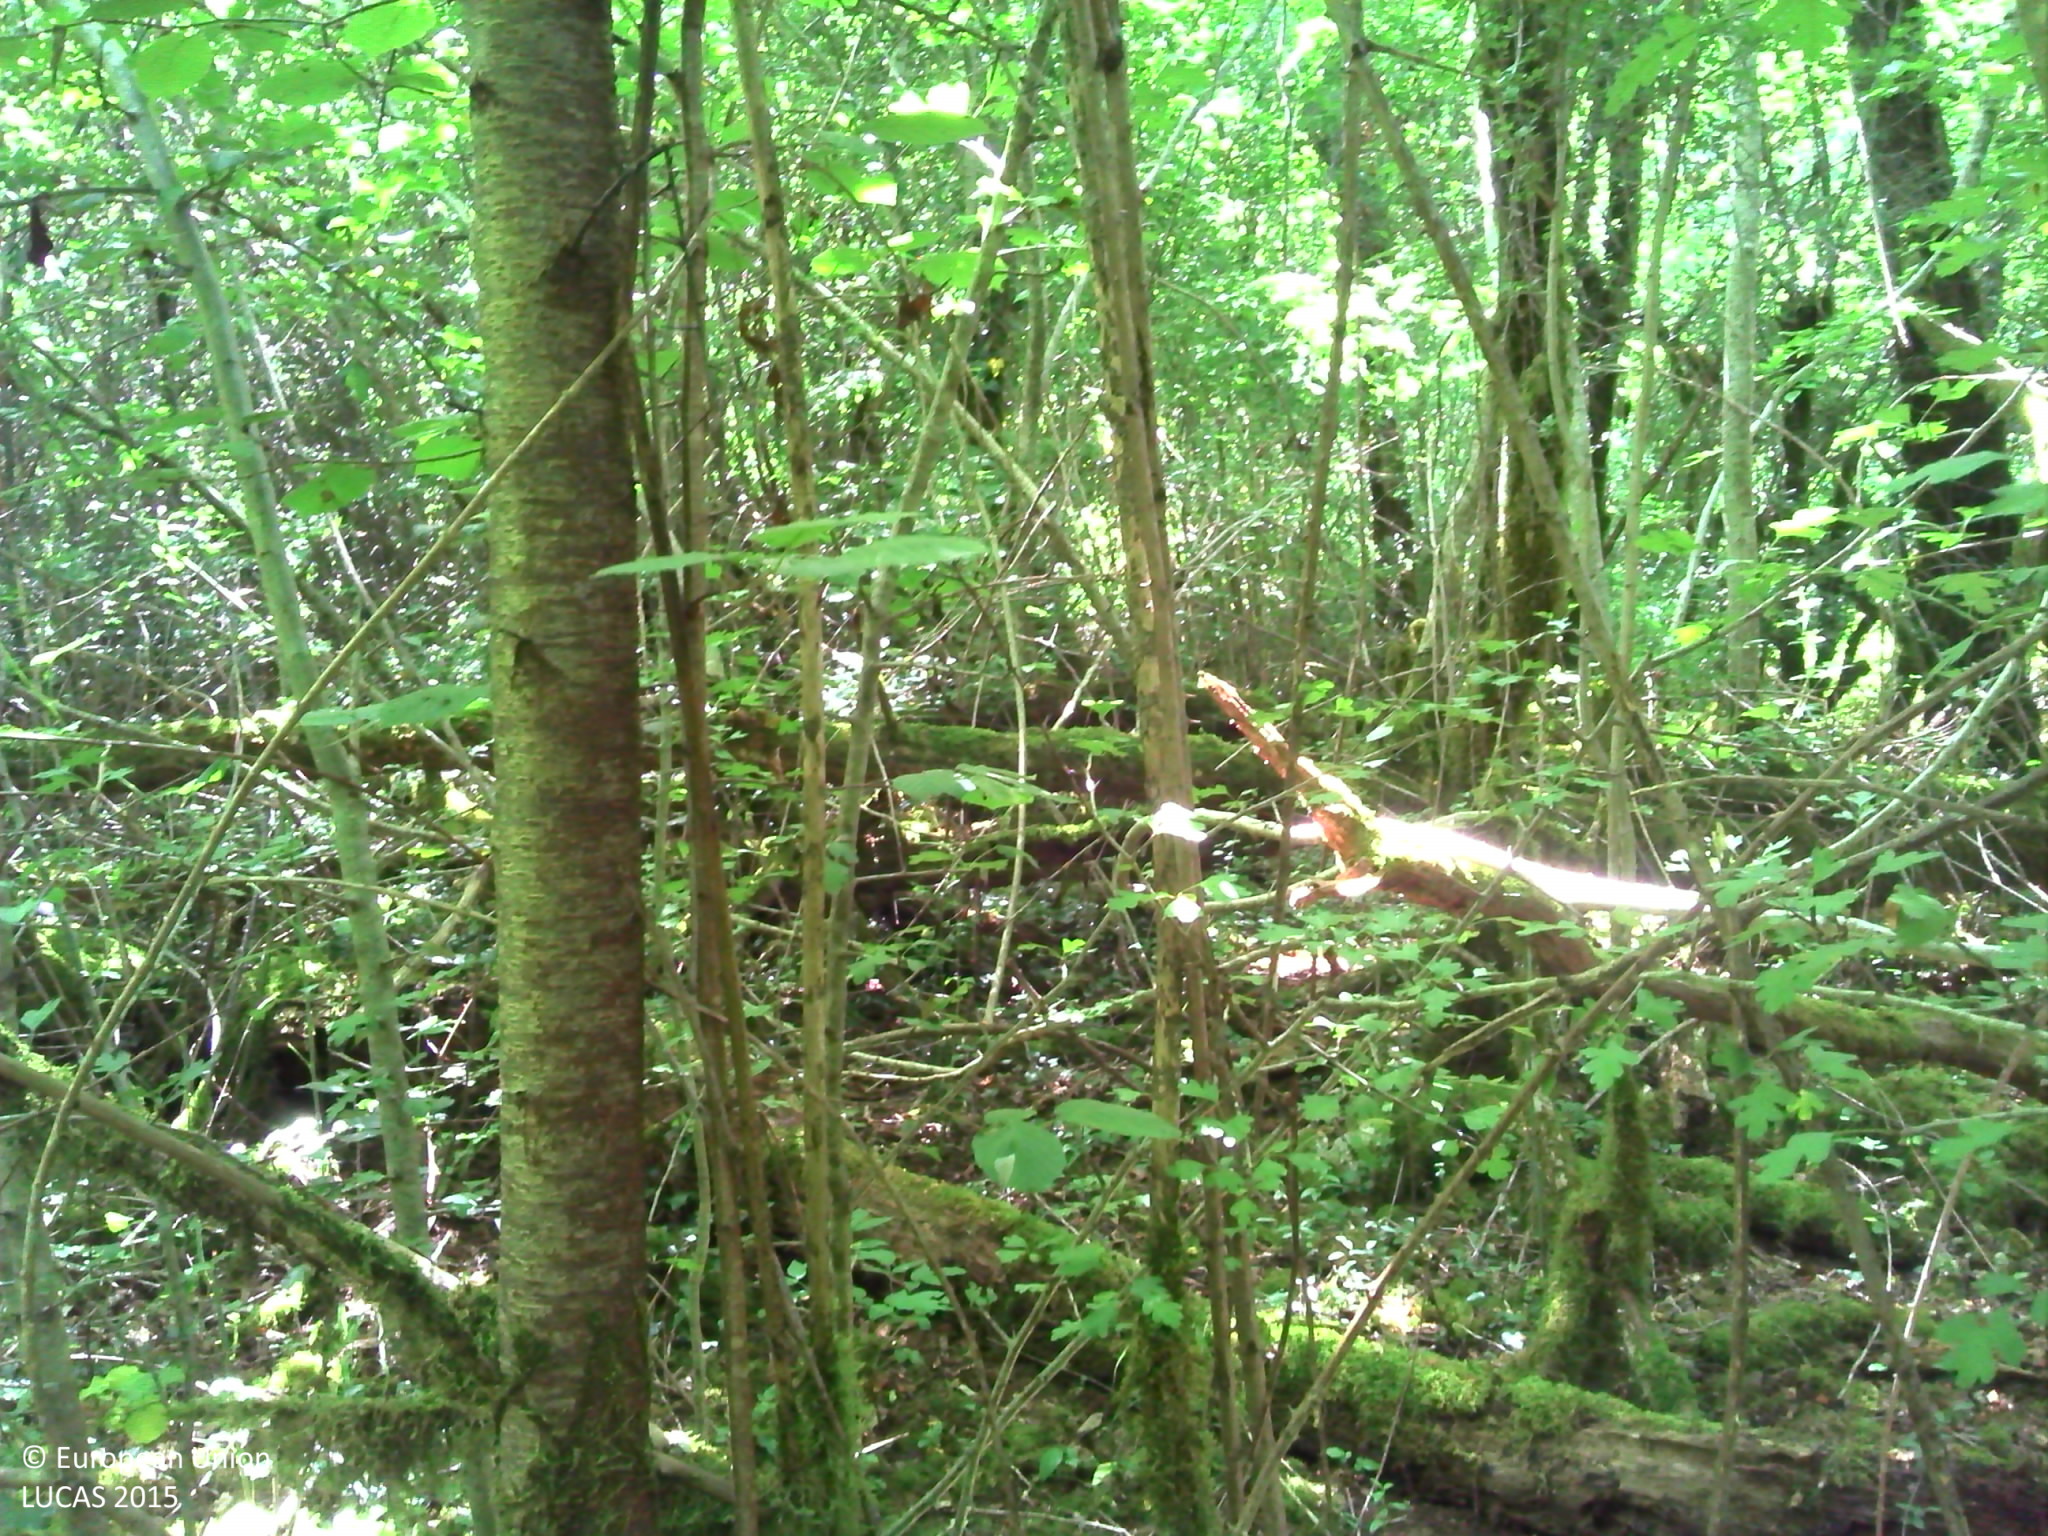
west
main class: Woodland
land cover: Broadleaved woodland
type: mesophytic deciduous forest
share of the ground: > 75 %
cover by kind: broadleaved forest trees 80 %, shrubs 15 %, herbaceous plants 5 %
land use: Forestry
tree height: > 5 m
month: June
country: FR
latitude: 45.7490
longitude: 0.3309
